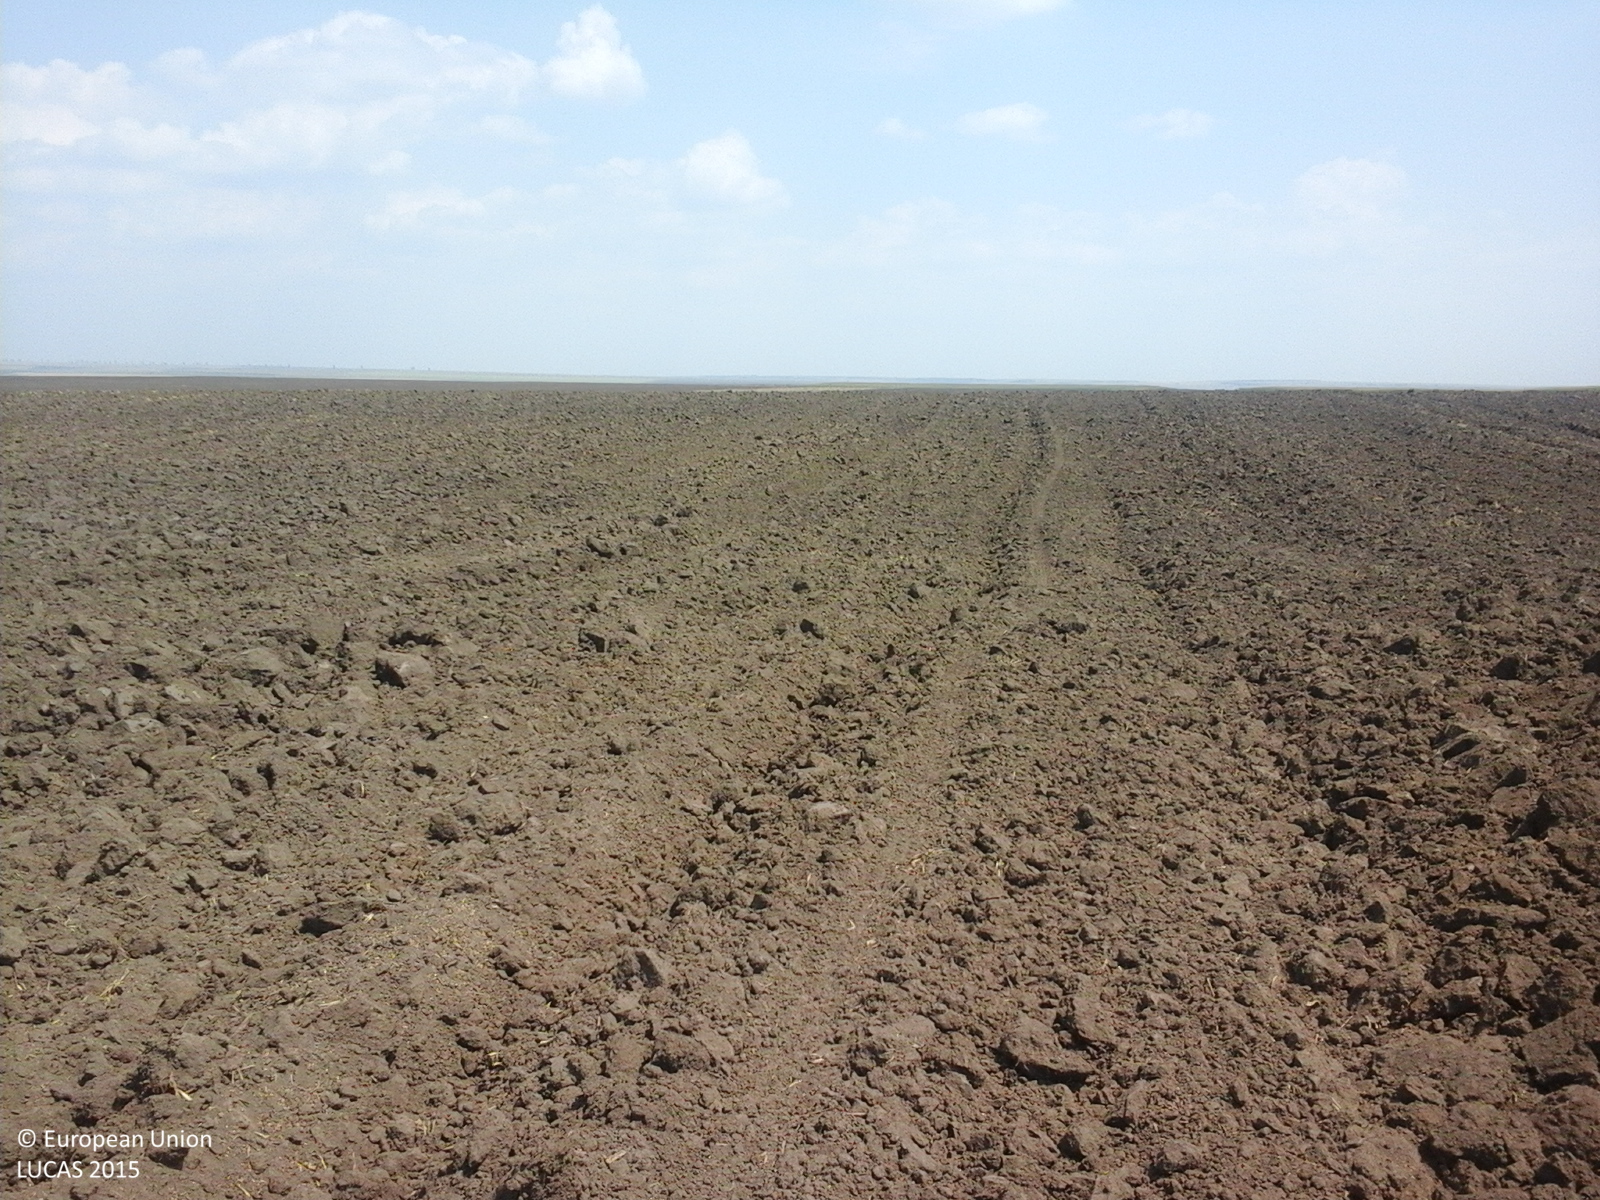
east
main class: Cropland
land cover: Common wheat
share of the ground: < 10 %
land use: Agriculture (excluding fallow land and kitchen gardens)
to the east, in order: Common wheat
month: July
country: RO
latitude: 45.9207
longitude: 27.5266
